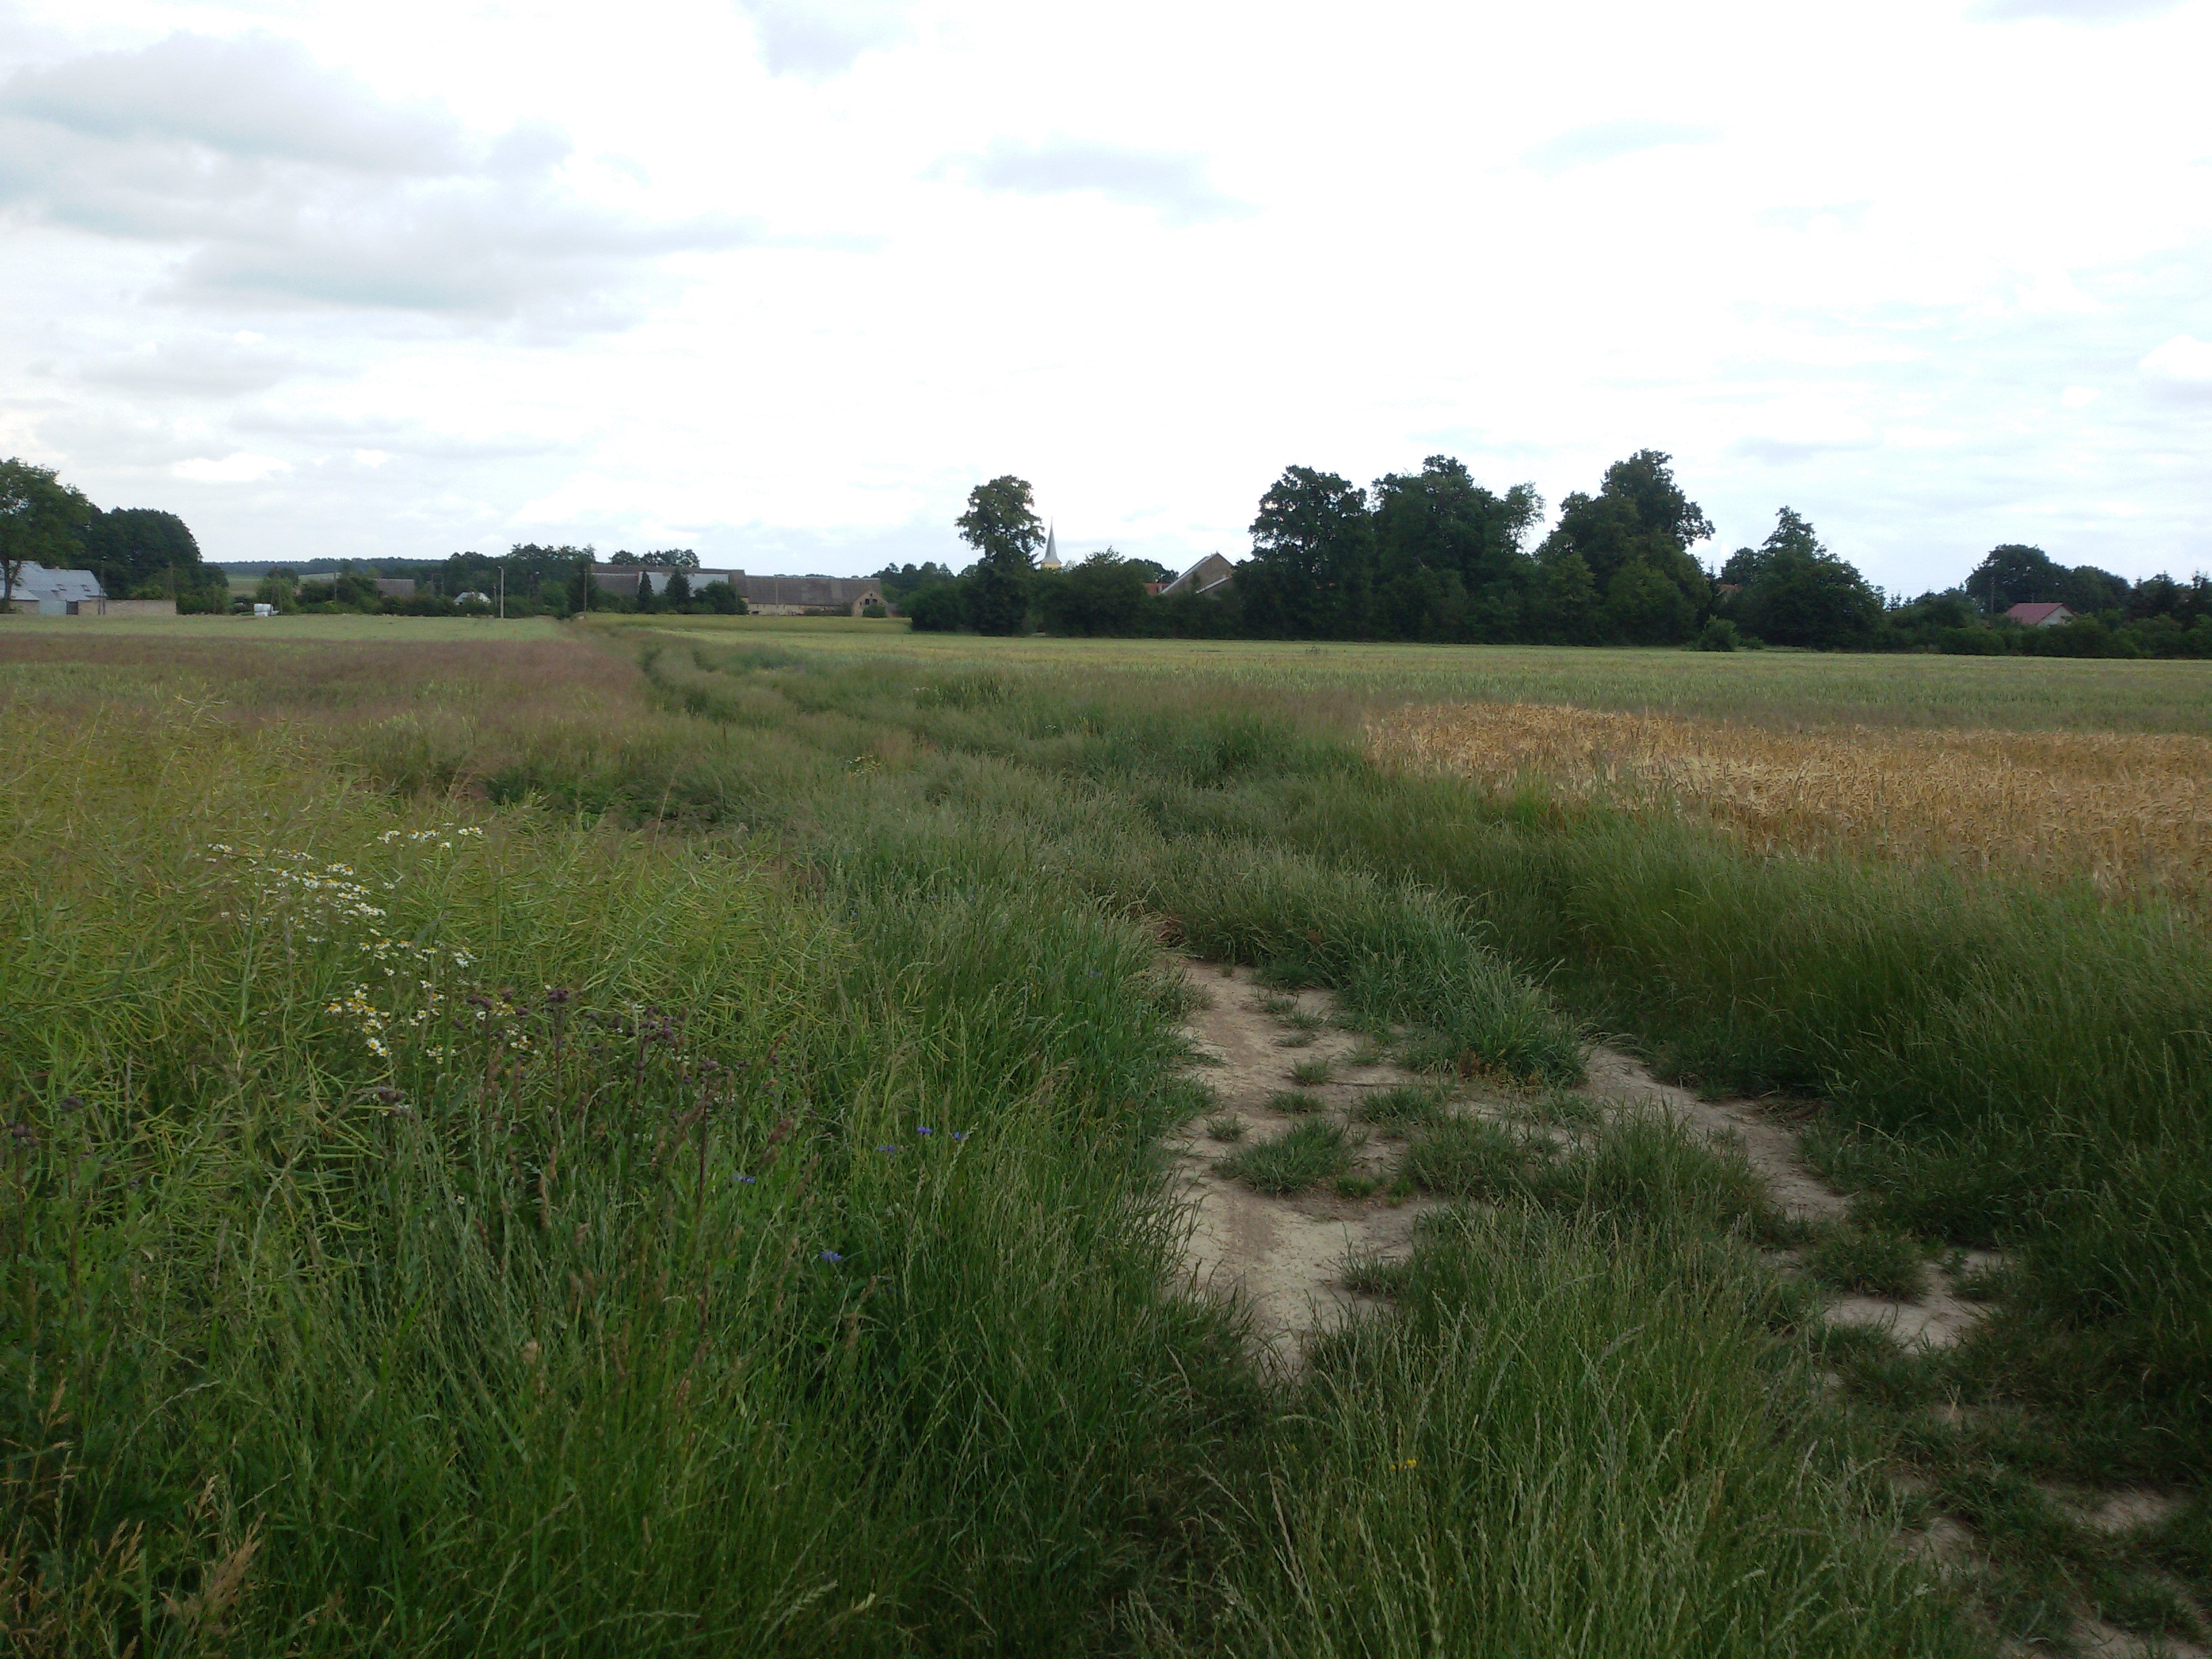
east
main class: Cropland
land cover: Rape and turnip rape
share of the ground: > 75 %
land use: Agriculture (excluding fallow land and kitchen gardens)
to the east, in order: Tracks; Rape and turnip rape; Tracks; Grass margins; Barley; Common wheat; Triticale; Tracks; Lines of trees; Common wheat
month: June
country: PL
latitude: 50.6956
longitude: 17.2171
